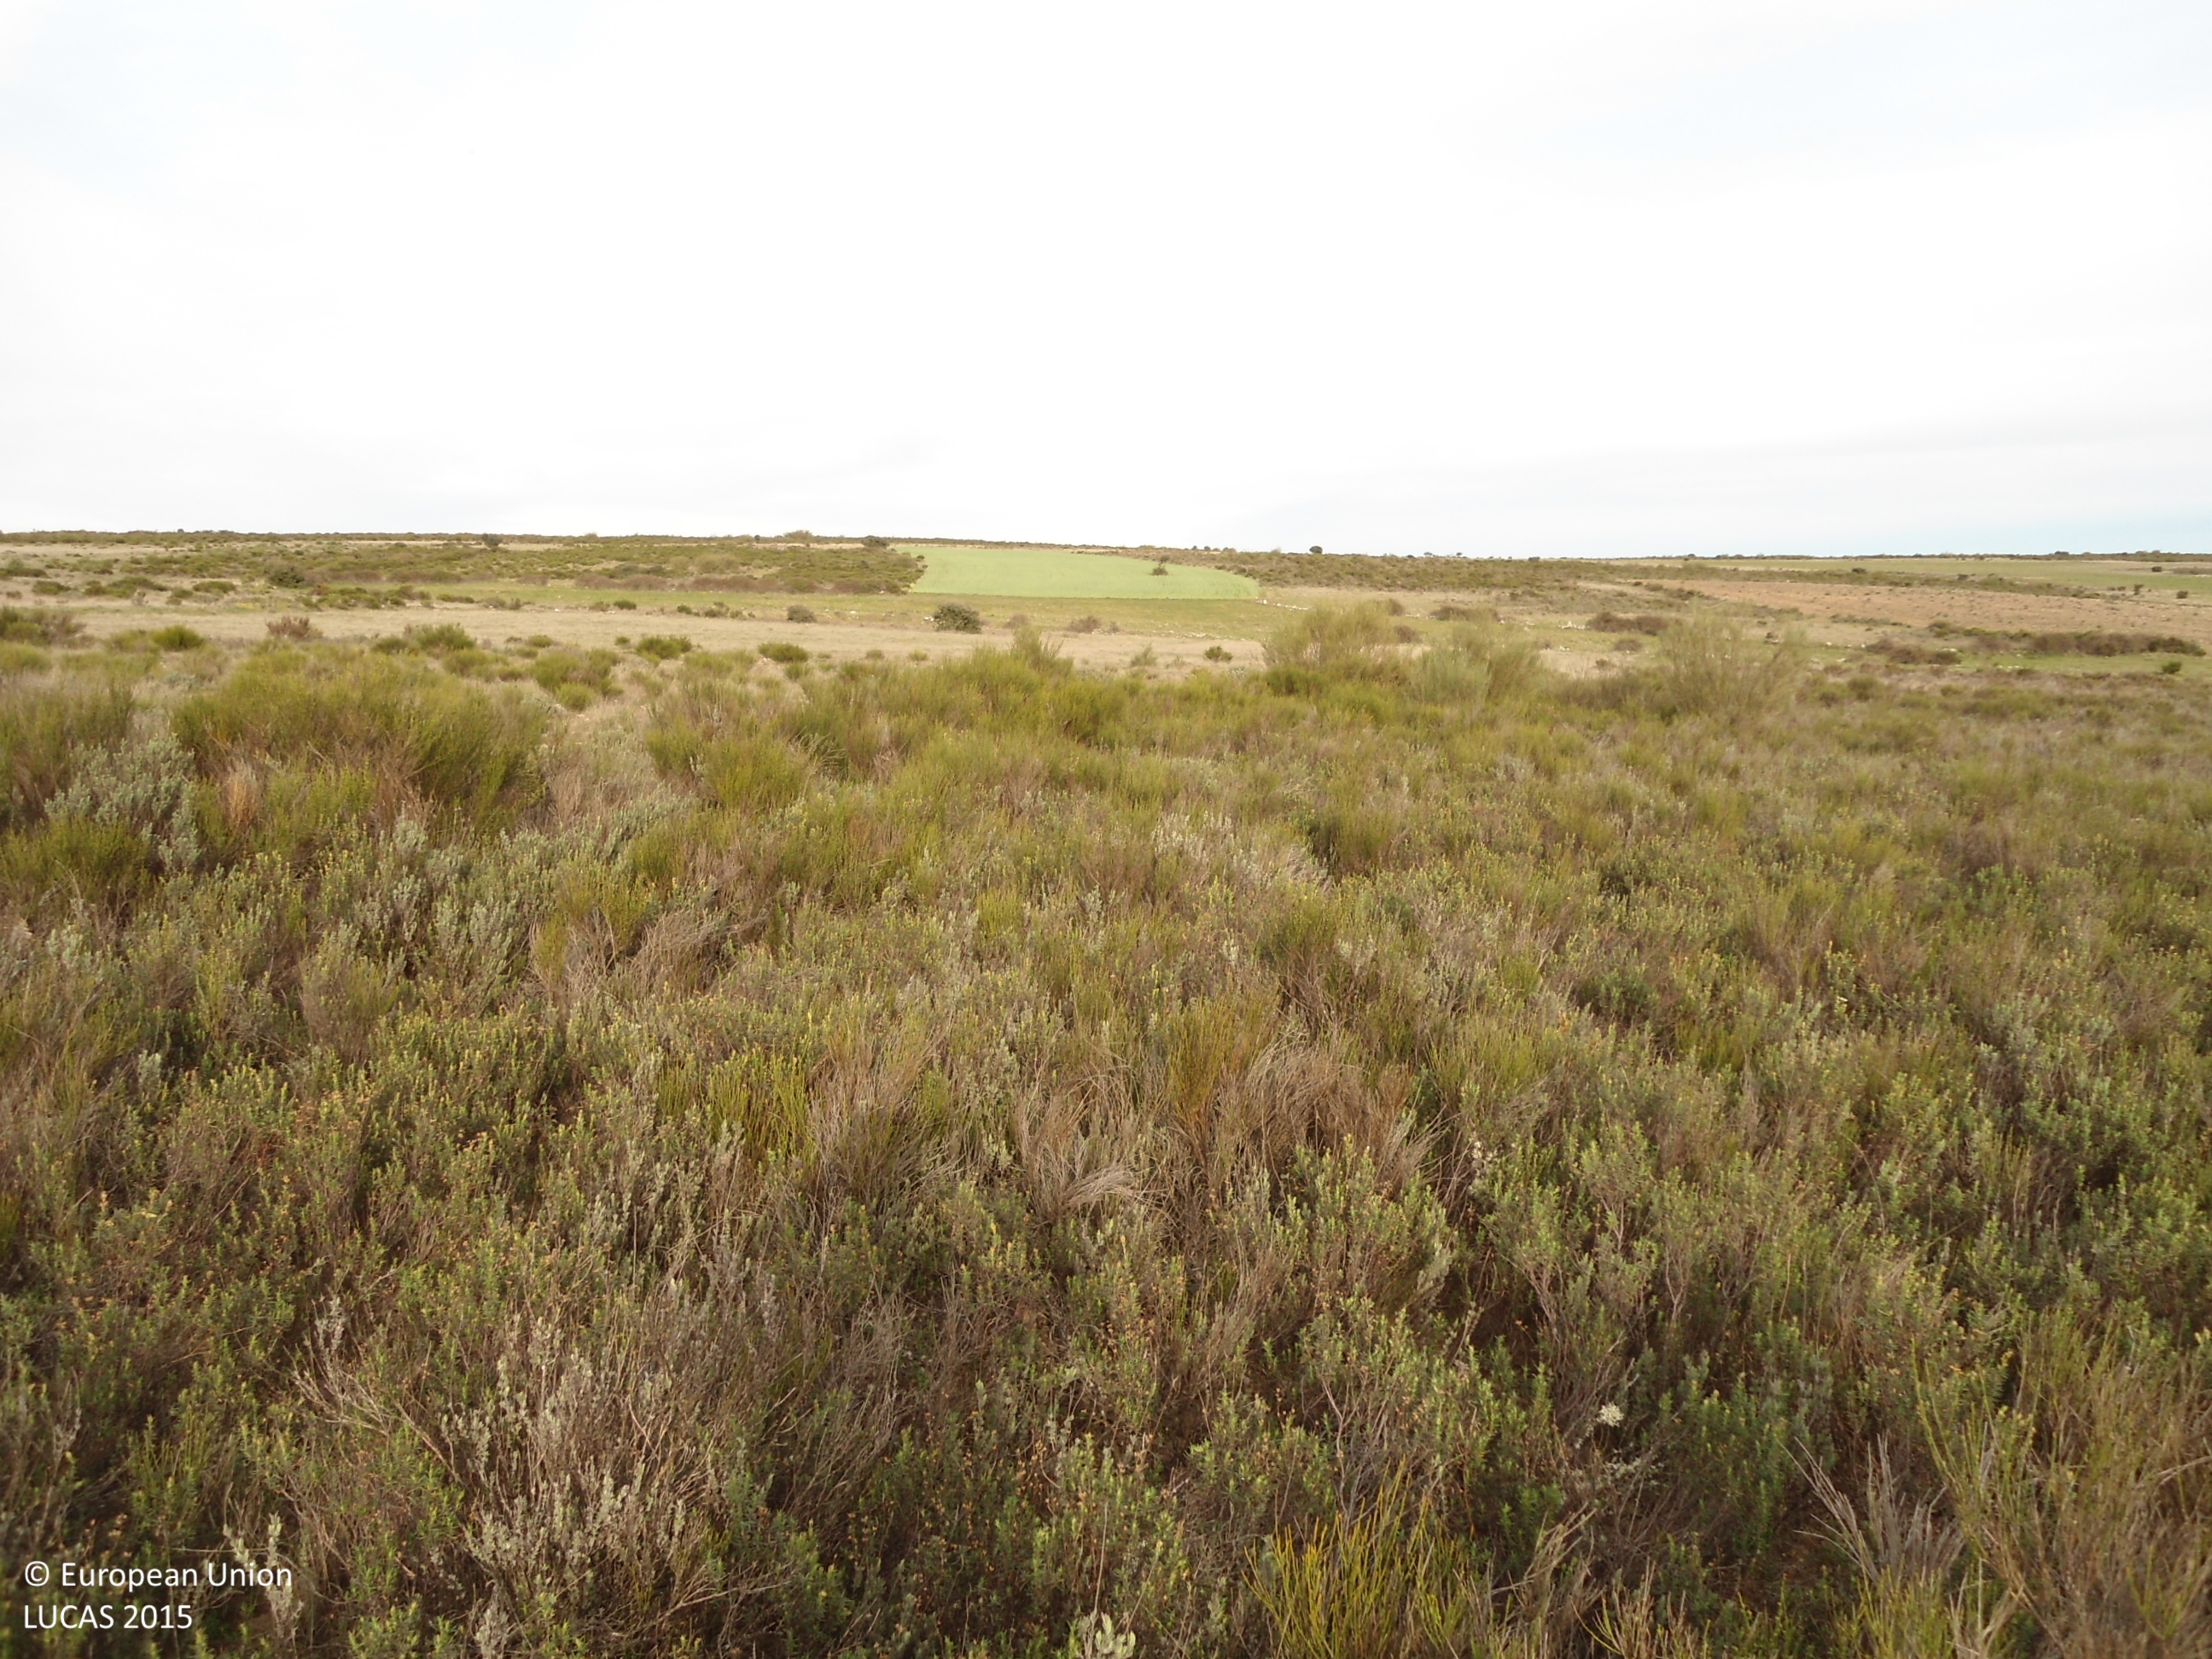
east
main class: Shrubland
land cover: Shrubland without tree cover
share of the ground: > 75 %
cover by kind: shrubs 90 %, herbaceous plants 10 %
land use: Fallow land
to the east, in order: Shrubland without tree cover; Grassland with sparse tree/shrub cover; Grassland without tree/shrub cover; Dry stone walls; Grassland without tree/shrub cover; Rye
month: April
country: ES
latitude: 41.5795
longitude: -6.0828
